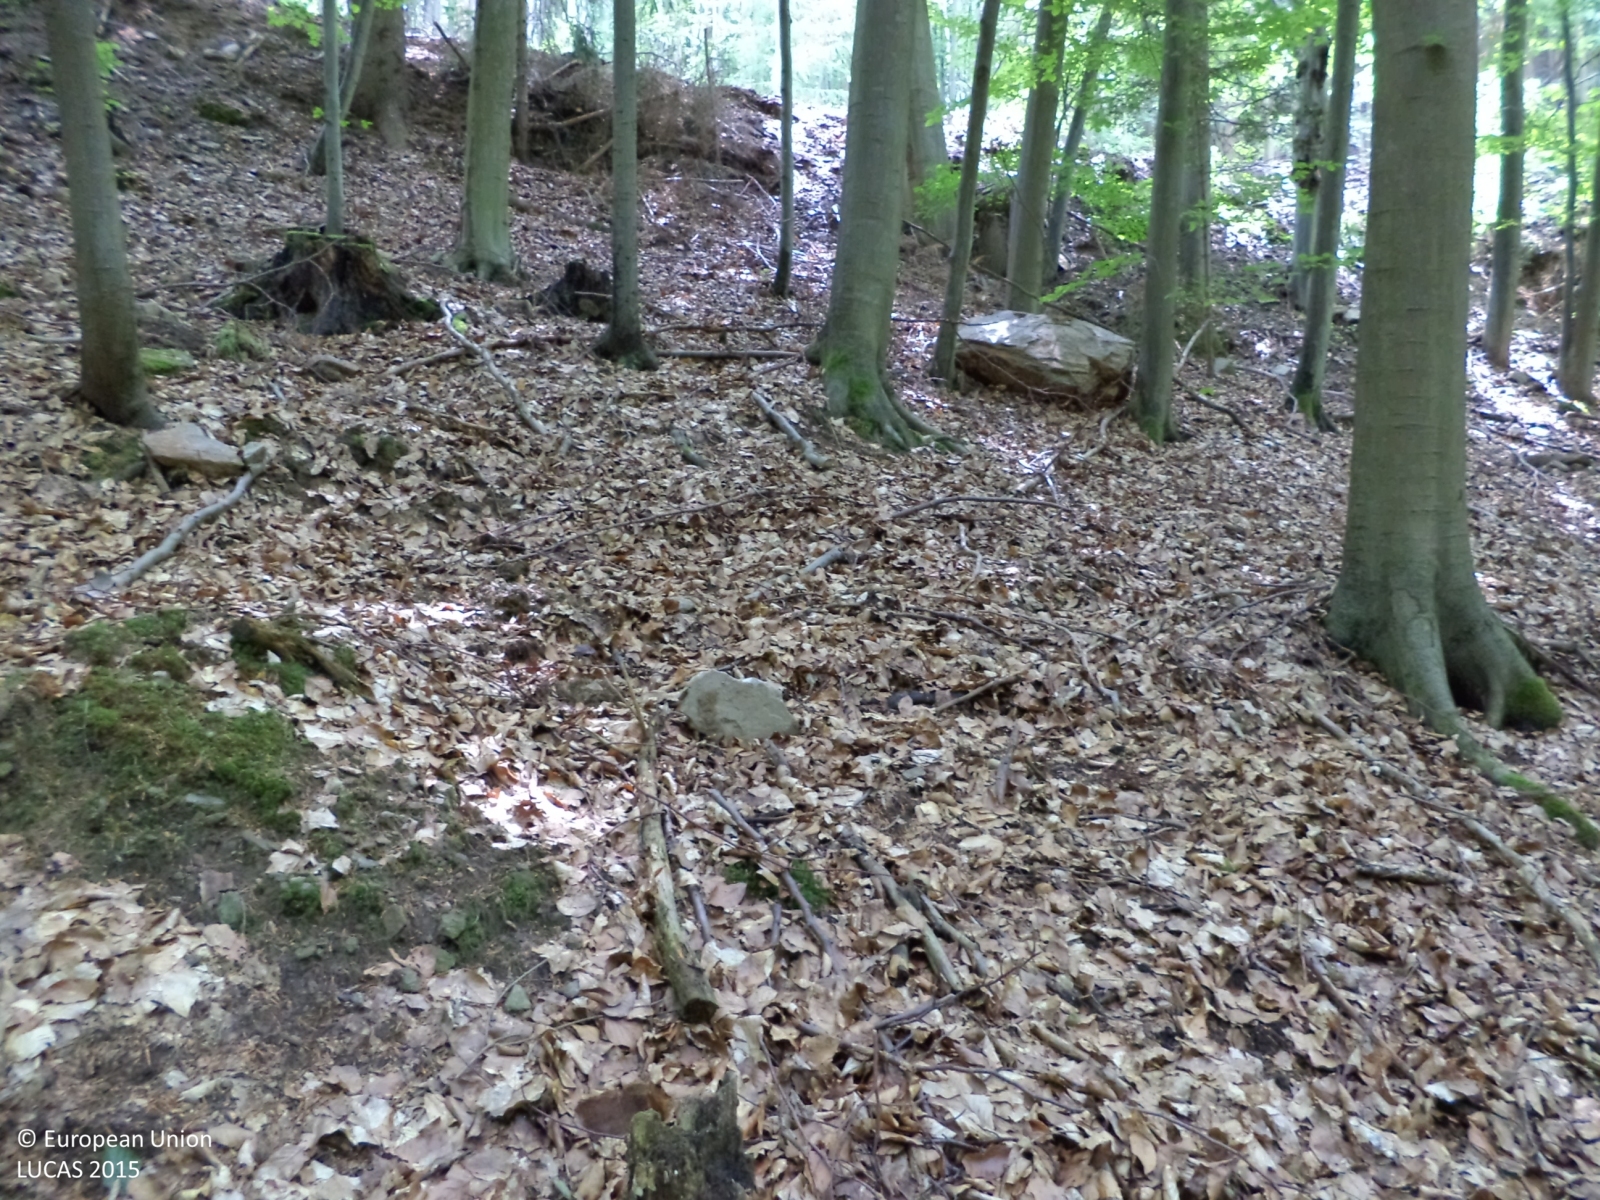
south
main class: Woodland
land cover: Broadleaved woodland
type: beech forest
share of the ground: > 75 %
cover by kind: broadleaved forest trees 100 %
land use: Forestry
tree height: > 5 m
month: June
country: CZ
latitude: 49.1066
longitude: 14.4531
